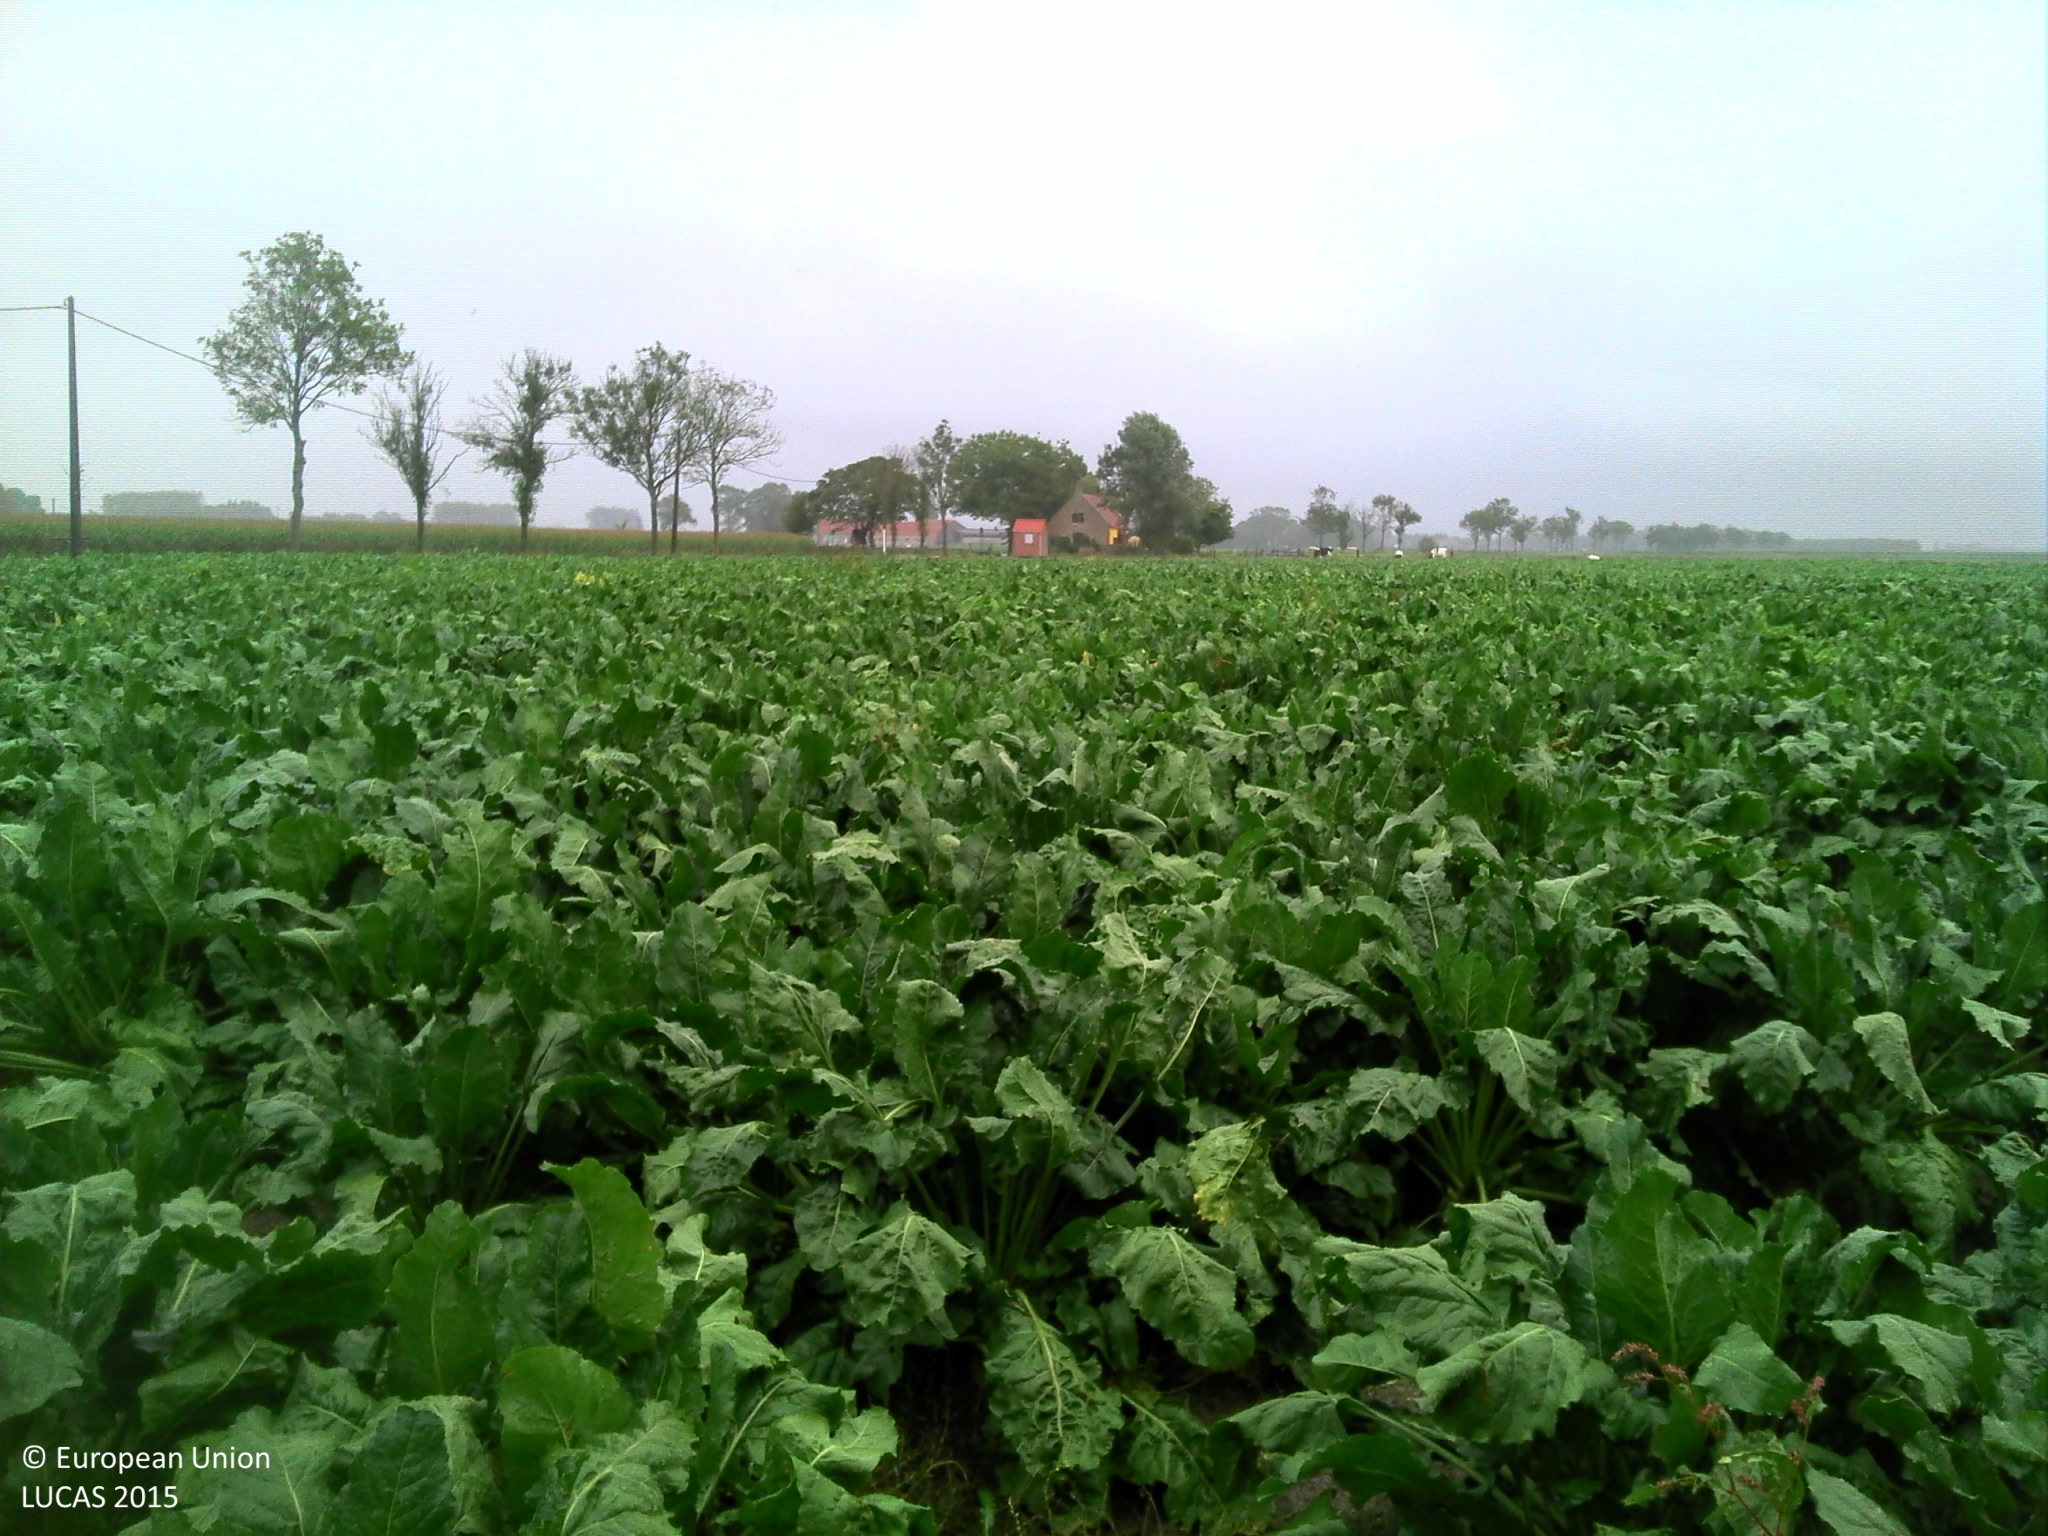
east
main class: Cropland
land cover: Sugar beet
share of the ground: > 75 %
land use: Agriculture (excluding fallow land and kitchen gardens)
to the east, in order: Sugar beet; Artificial constructions in urban areas; Ditches and canals; Artificial constructions in urban areas; Grassland without tree/shrub cover; Ditches and canals
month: September
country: BE
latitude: 51.1103
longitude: 2.7754
